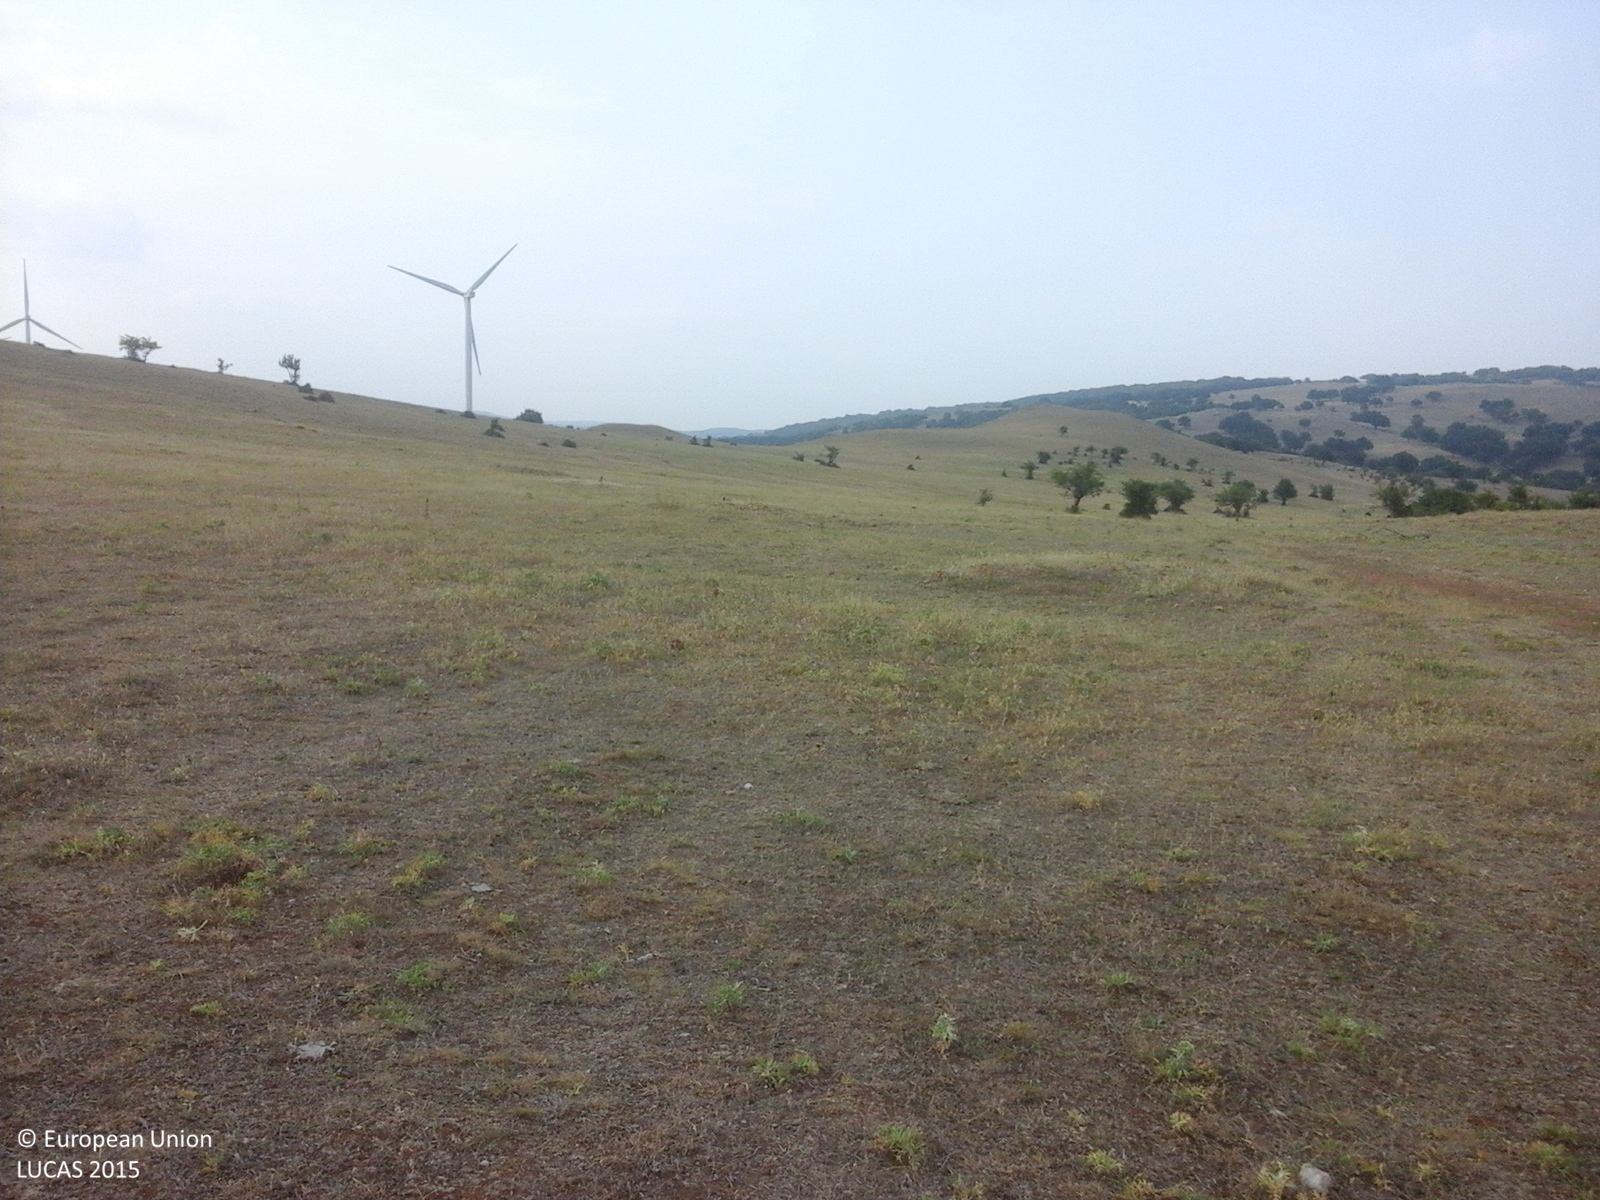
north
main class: Grassland
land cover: Grassland without tree/shrub cover
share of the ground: > 75 %
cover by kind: herbaceous plants 100 %
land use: Agriculture (excluding fallow land and kitchen gardens)
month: July
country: RO
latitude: 45.0600
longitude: 28.3478
